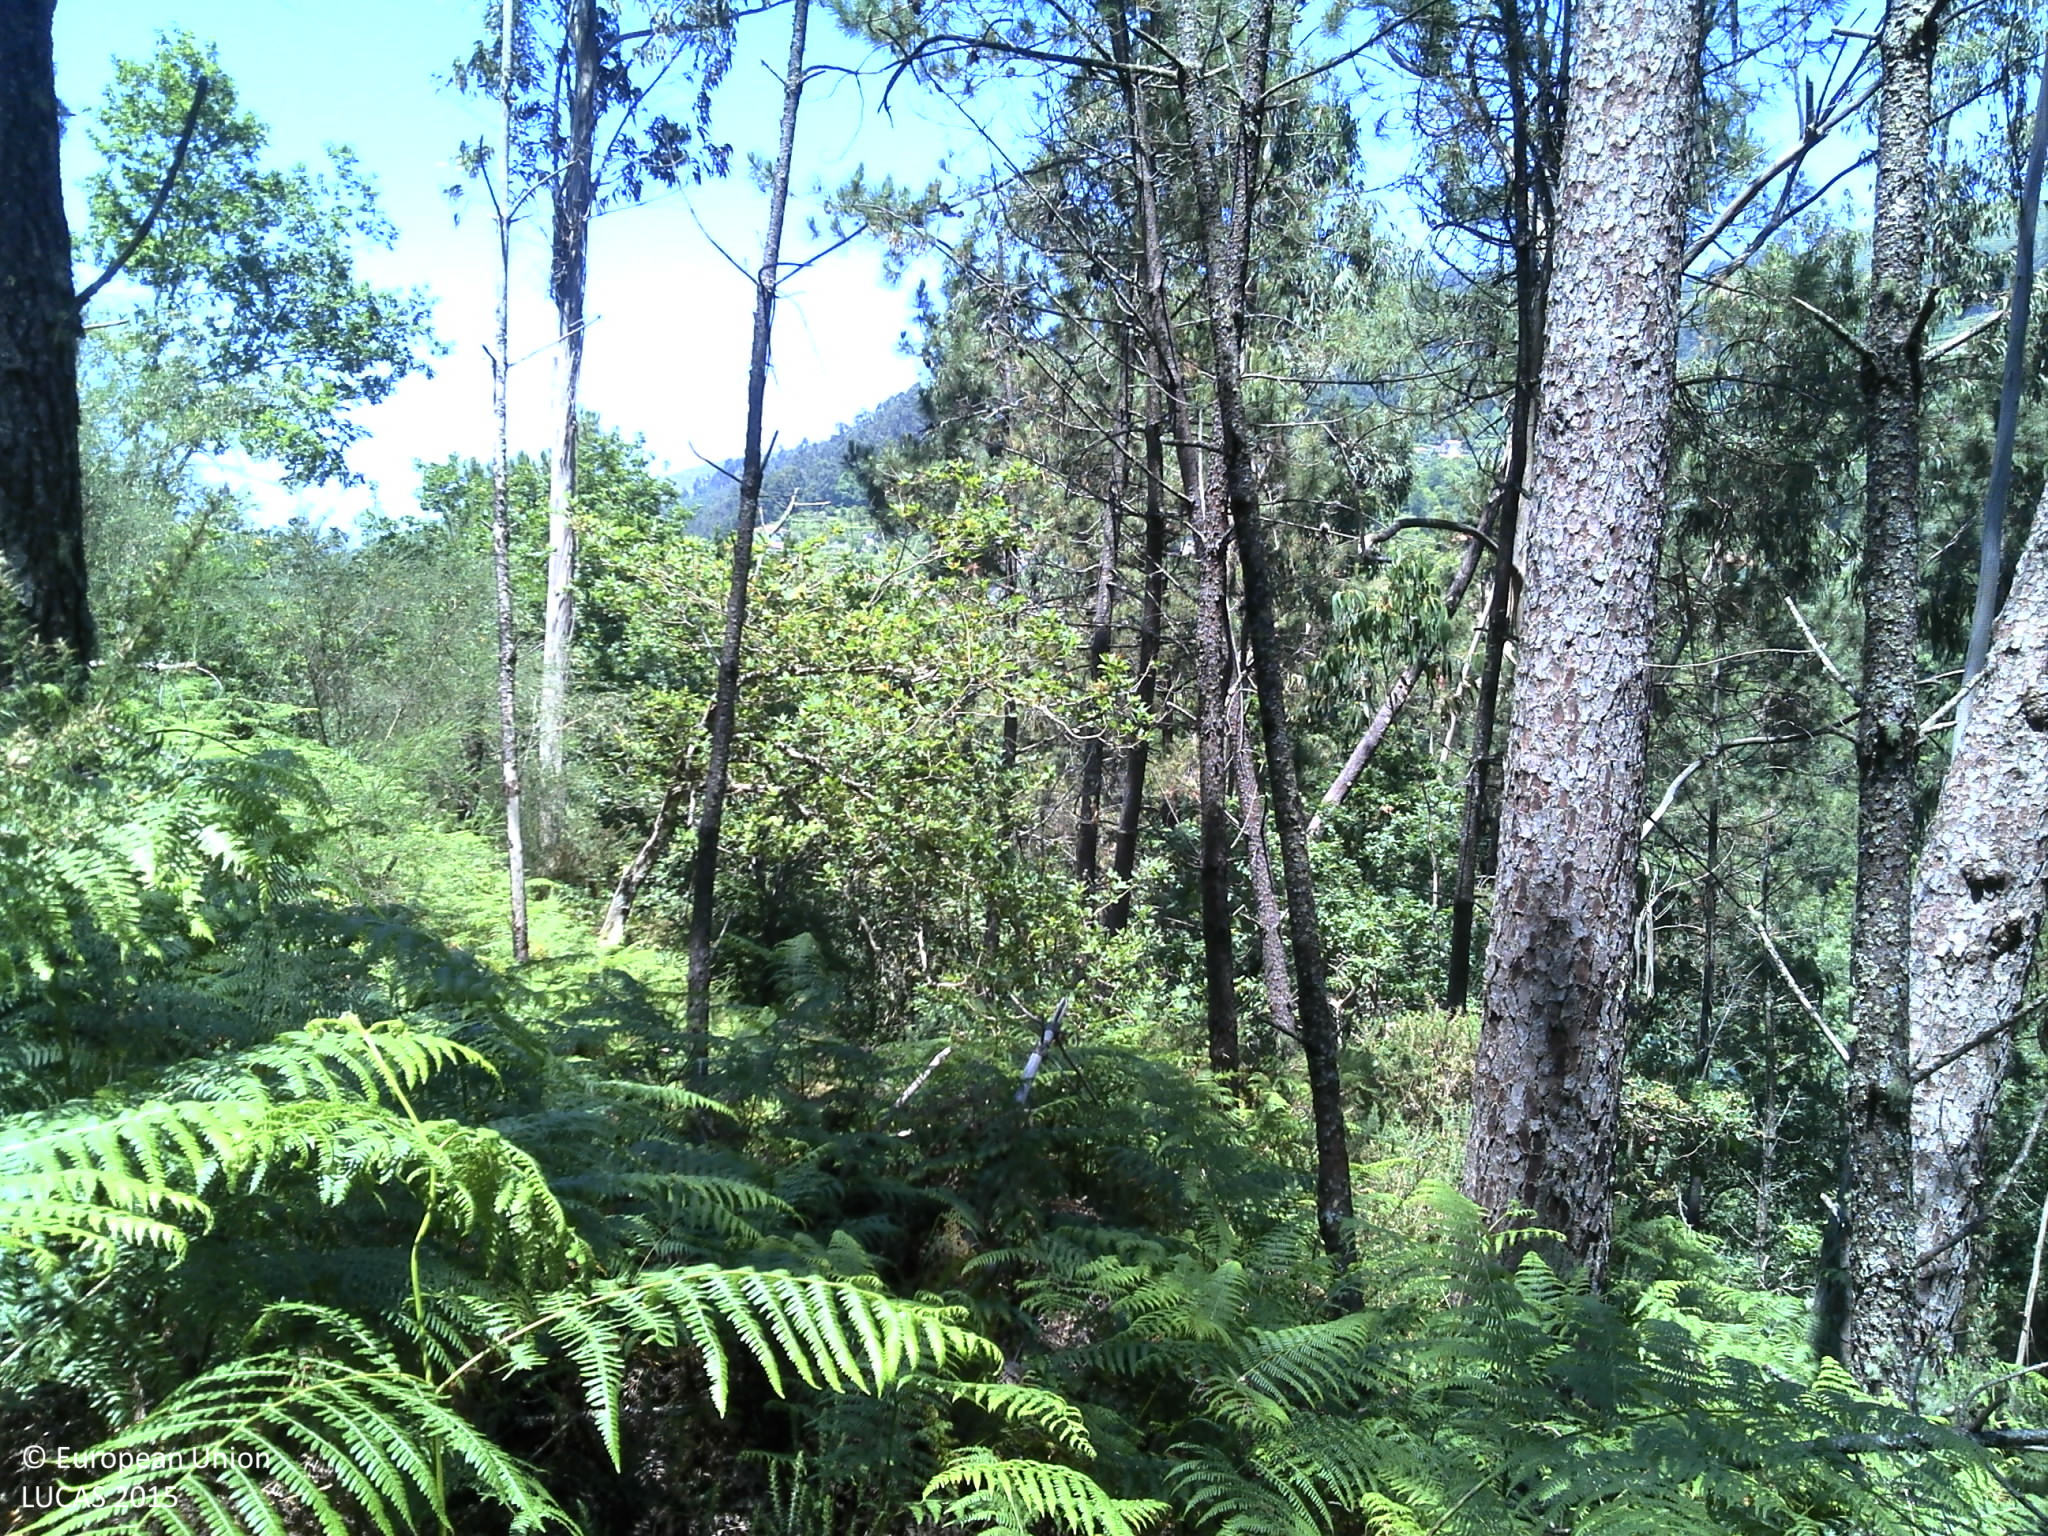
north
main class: Woodland
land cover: Pine dominated mixed woodland
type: coniferous forest of the mediterranean region
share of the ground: 50 - 75 %
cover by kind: coniferous forest trees 75 %, broadleaved forest trees 25 %
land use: Forestry
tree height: > 5 m
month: June
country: PT
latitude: 41.9380
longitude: -8.4578
